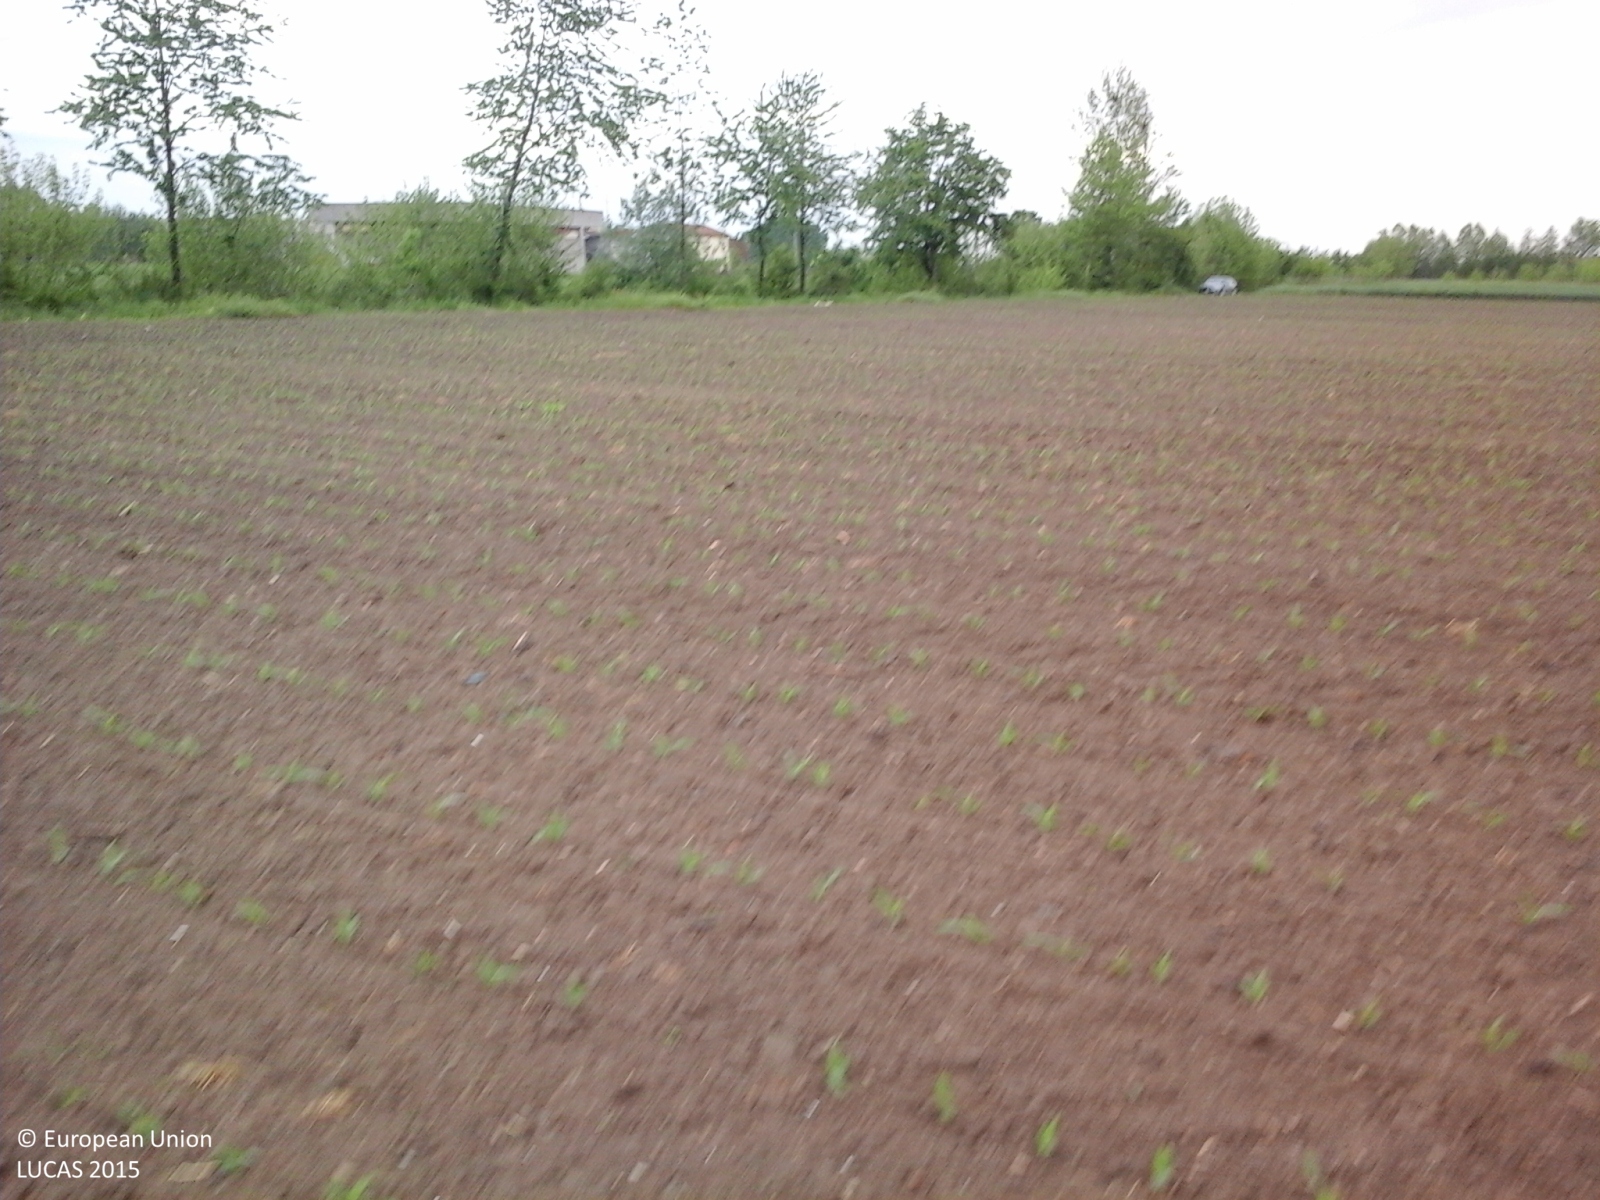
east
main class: Cropland
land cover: Maize
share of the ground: < 10 %
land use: Agriculture (excluding fallow land and kitchen gardens)
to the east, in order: Maize; Tracks; Grass margins; Managed hedges; Ditches and canals; Managed hedges; Temporary grasslands; Ditches and canals; Grass margins; Maize; Electric lines; Maize; Artificial constructions in urban areas
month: April
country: IT
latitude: 45.2863
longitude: 10.6236
